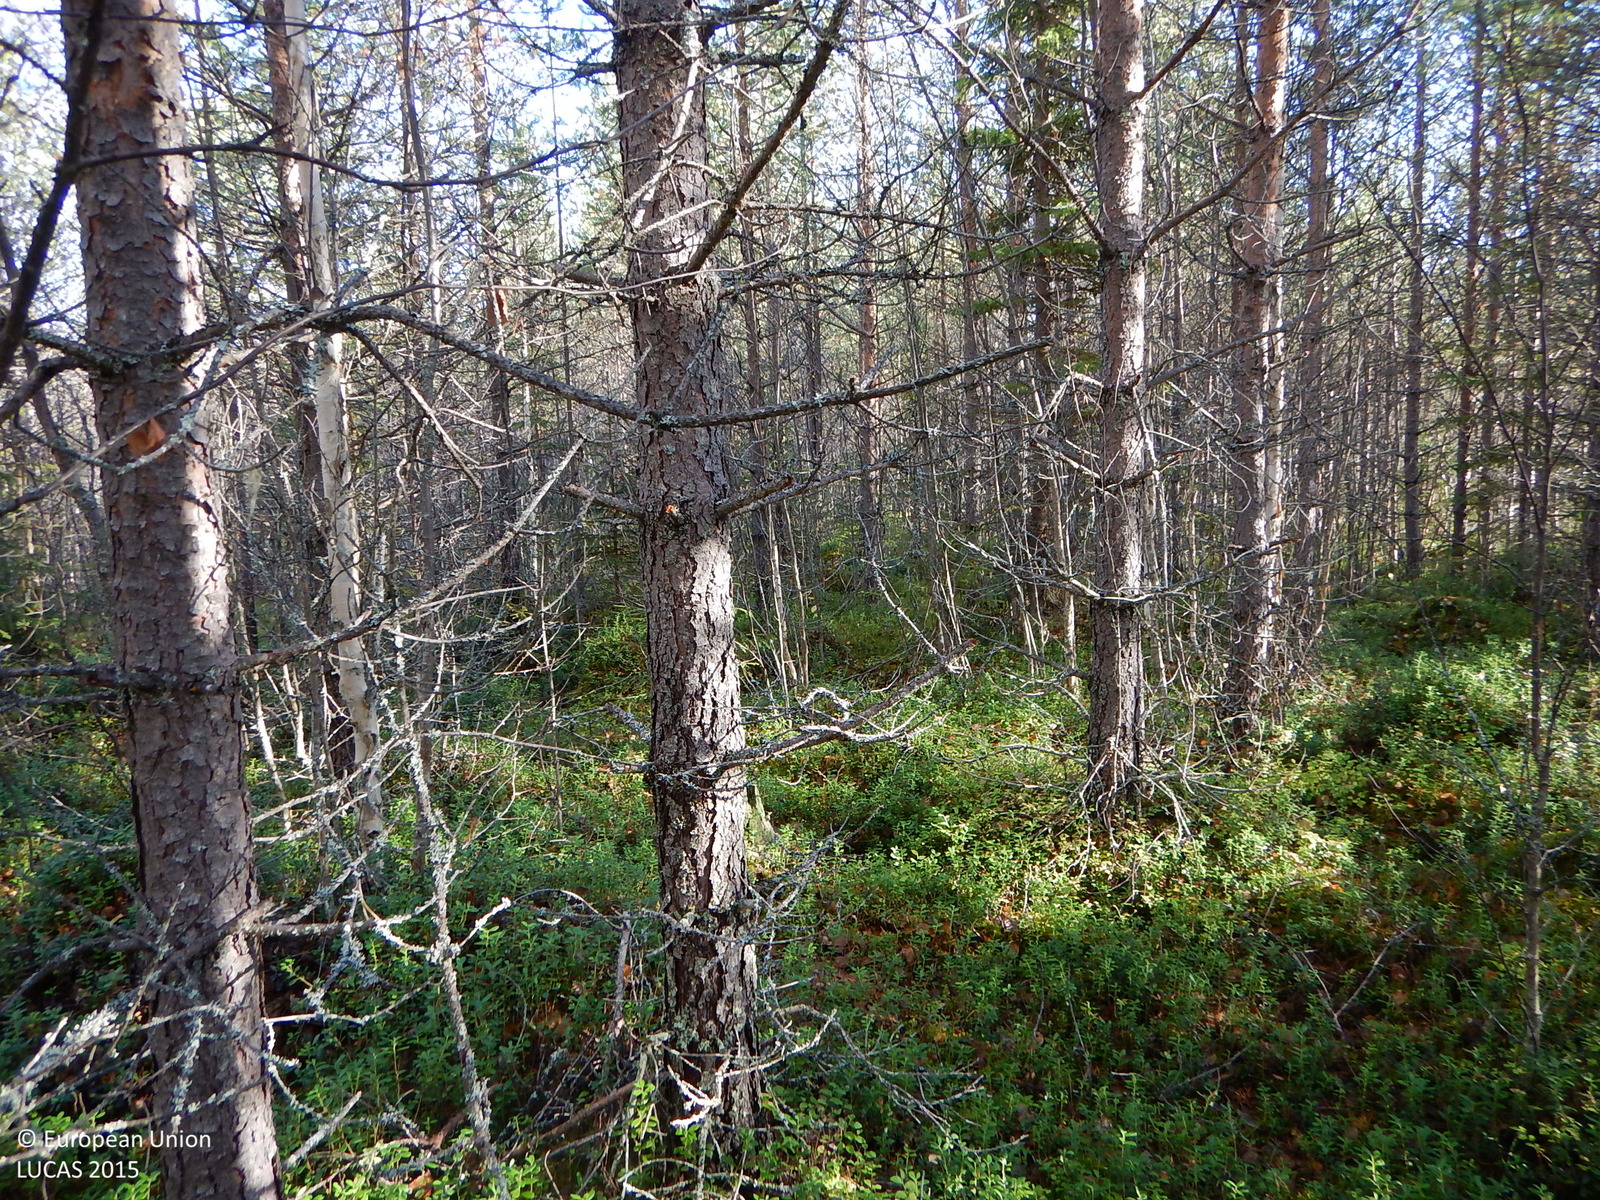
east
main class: Woodland
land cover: Pine dominated mixed woodland
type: boreal forest
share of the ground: 50 - 75 %
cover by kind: coniferous forest trees 50 %, broadleaved forest trees 20 %, shrubs 15 %, herbaceous plants 15 %
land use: Forestry
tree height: > 5 m
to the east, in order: Pine dominated mixed woodland; Other mixed woodland; Rivers and streams; Other mixed woodland; Pine dominated mixed woodland
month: September
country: SE
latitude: 64.9299
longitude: 20.1445
